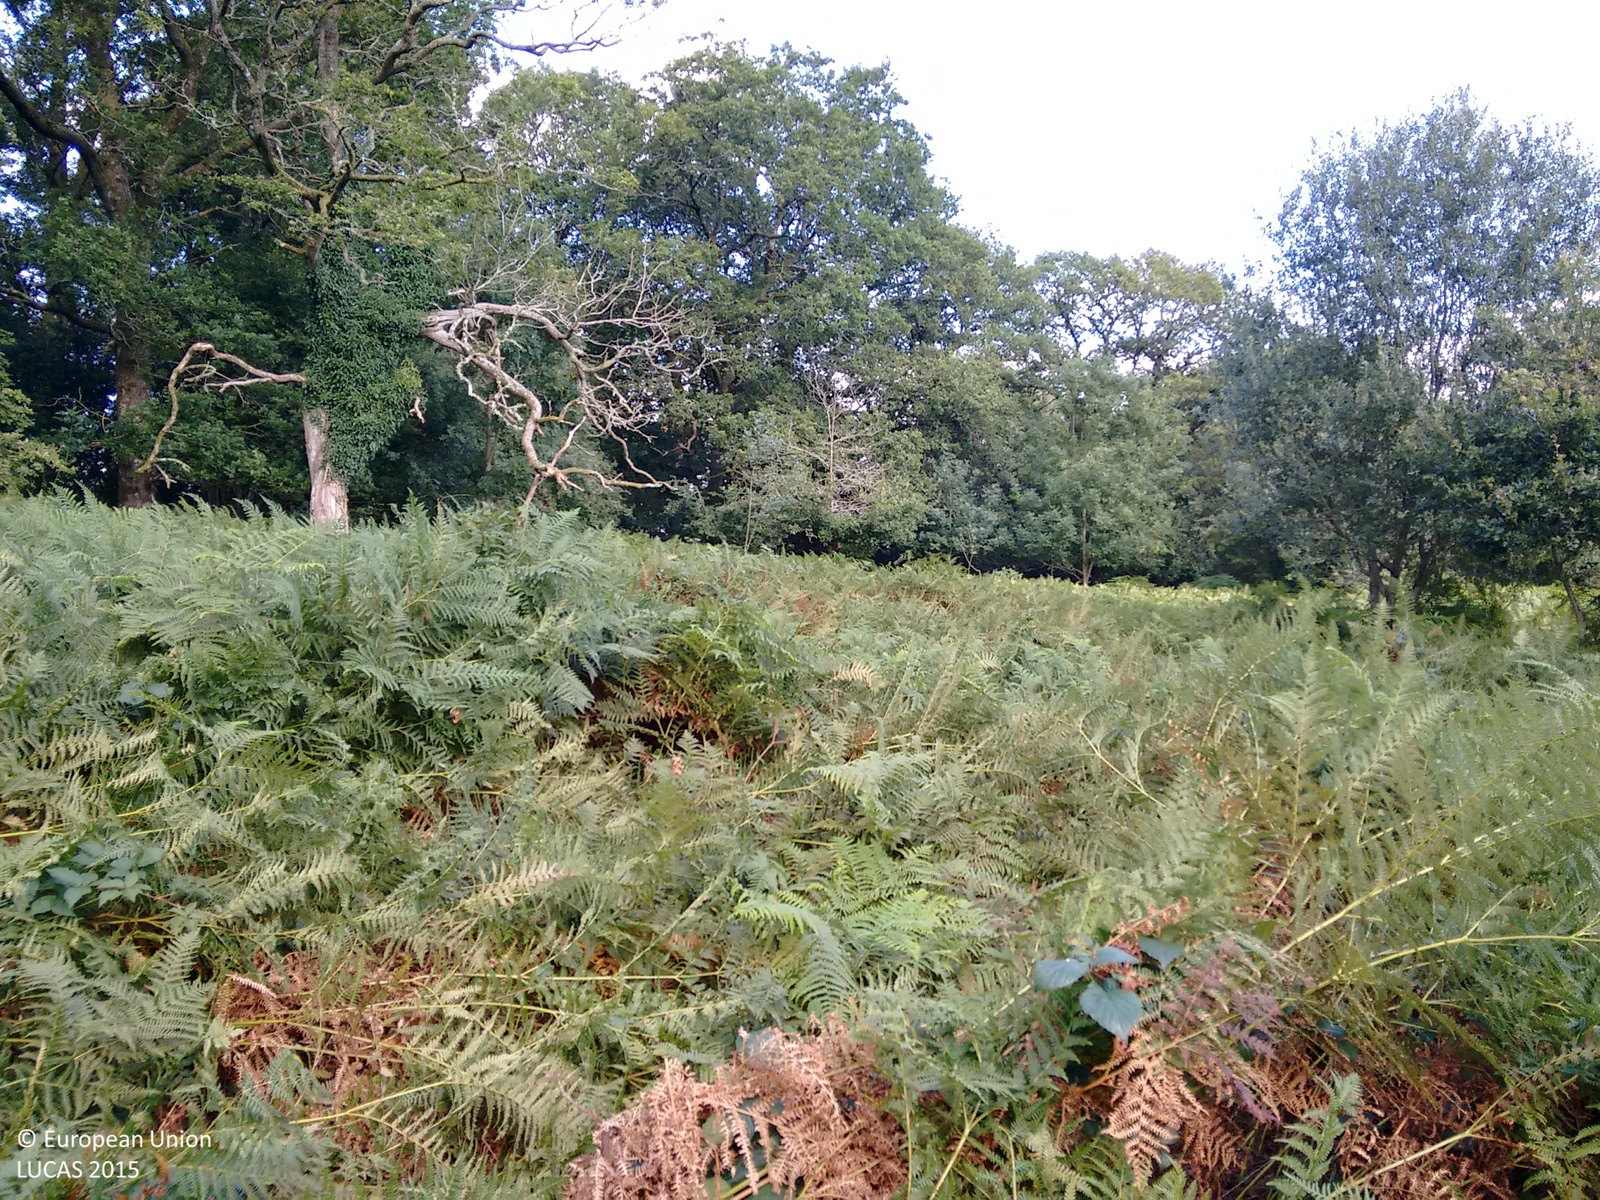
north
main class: Woodland
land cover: Broadleaved woodland
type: mesophytic deciduous forest
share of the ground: > 75 %
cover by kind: herbaceous plants 80 %, broadleaved forest trees 20 %
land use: Agriculture (excluding fallow land and kitchen gardens)
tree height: < 5 m
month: September
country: GB
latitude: 52.1504
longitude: -3.4861
